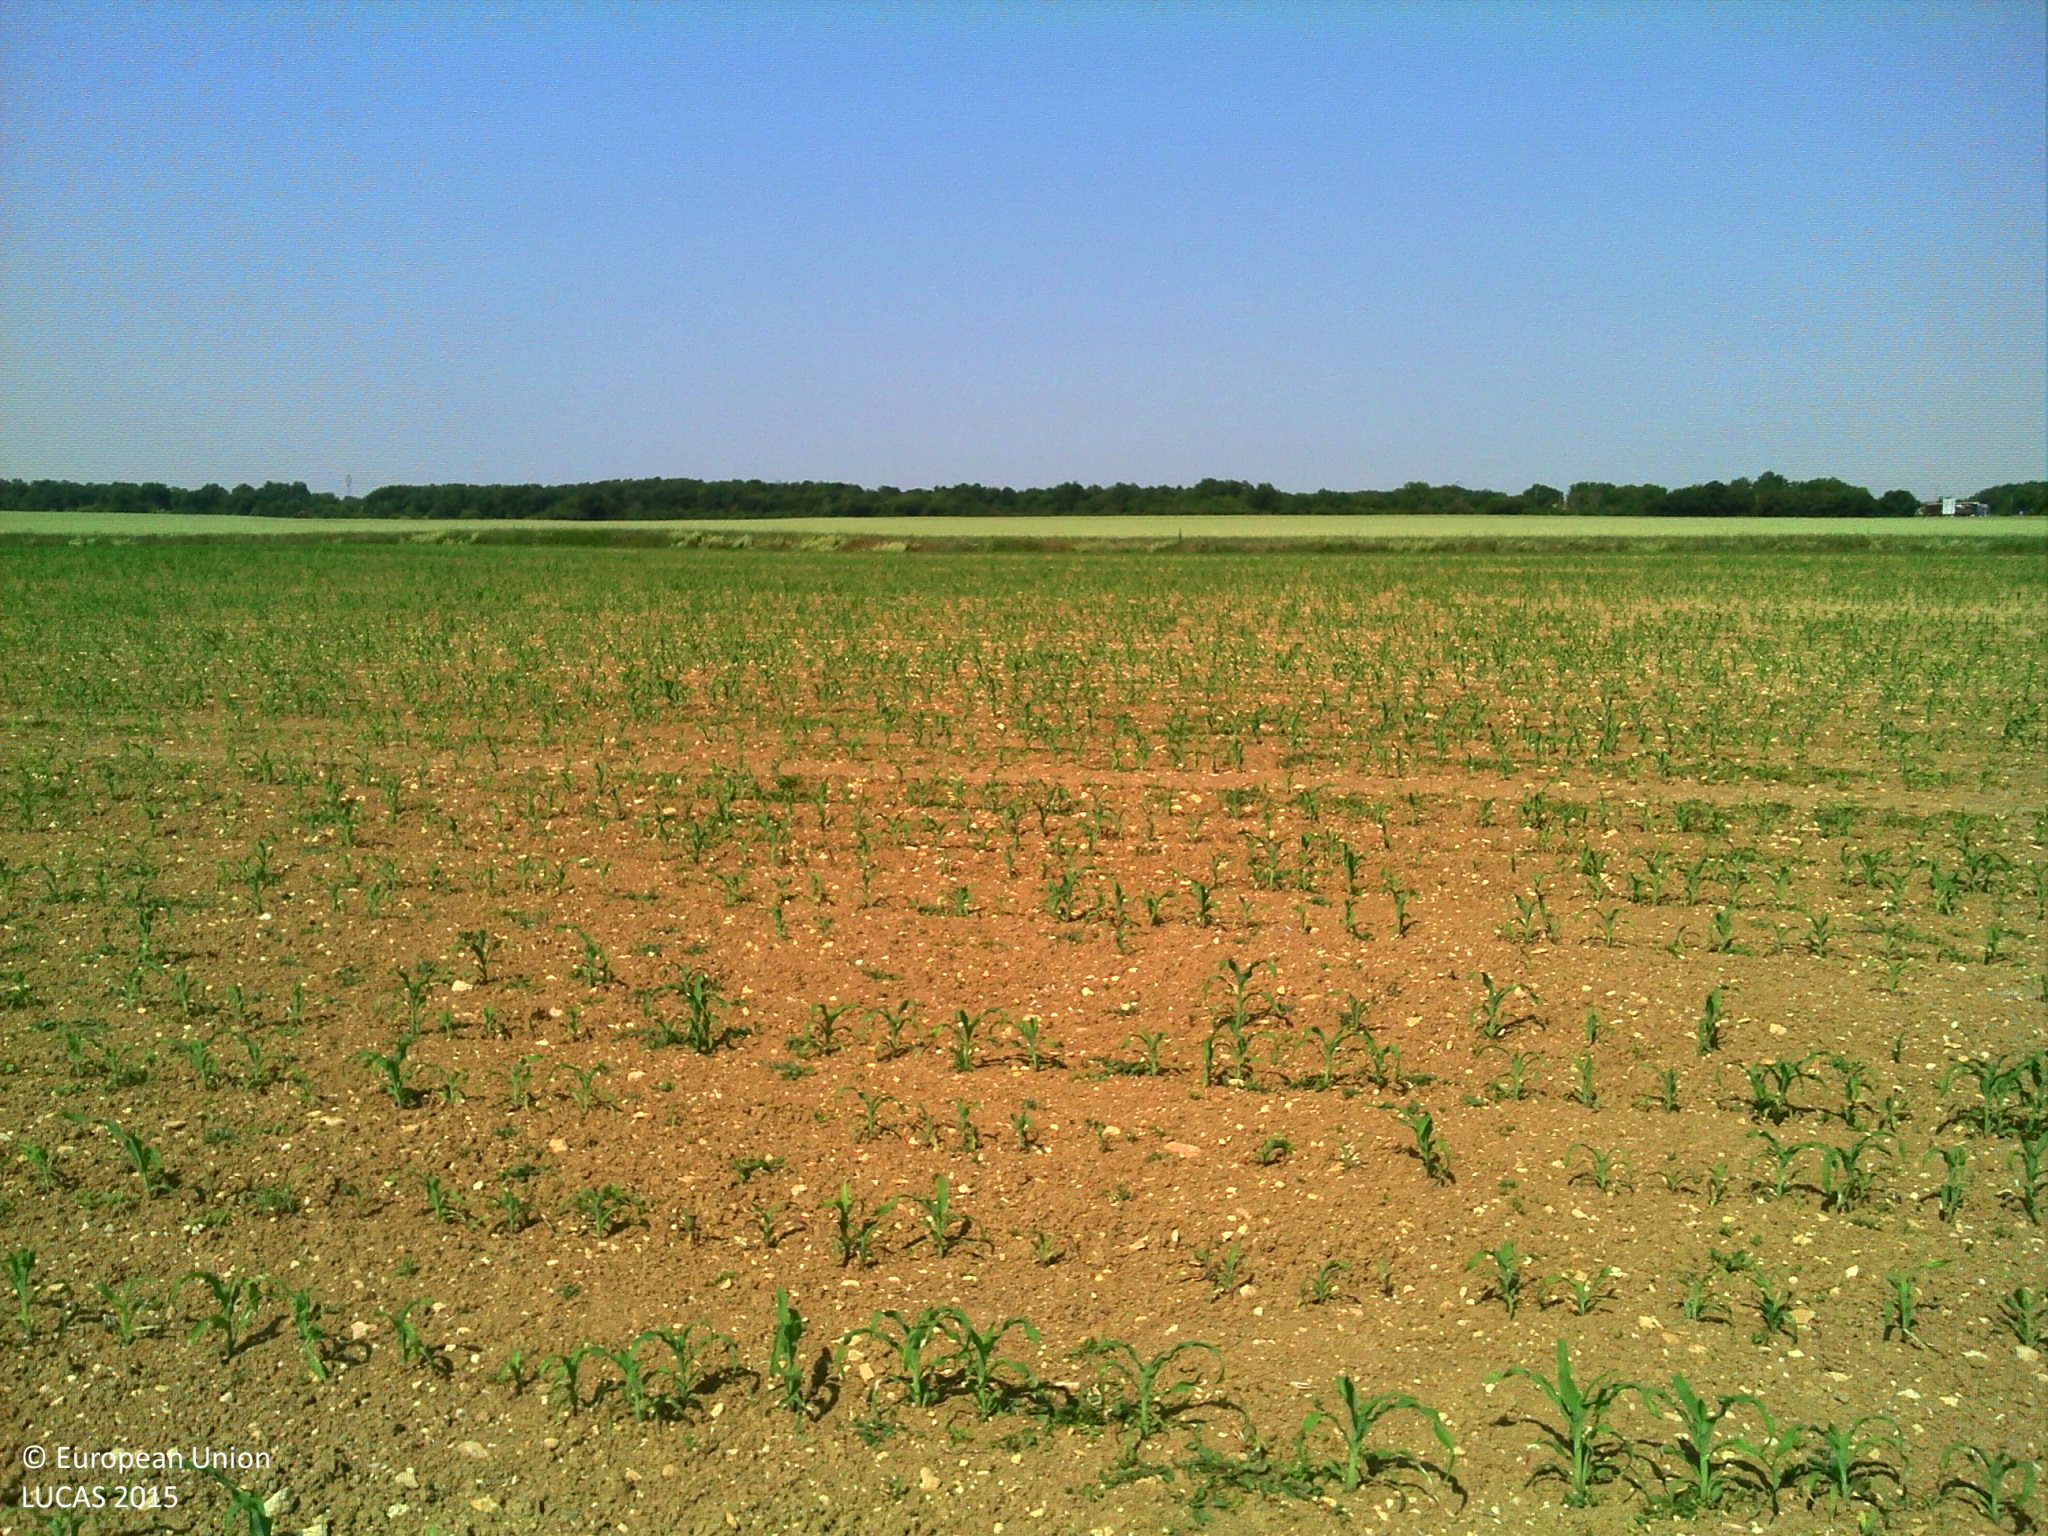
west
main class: Cropland
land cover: Maize
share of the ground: < 10 %
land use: Agriculture (excluding fallow land and kitchen gardens)
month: June
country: FR
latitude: 46.0800
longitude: -0.9299
